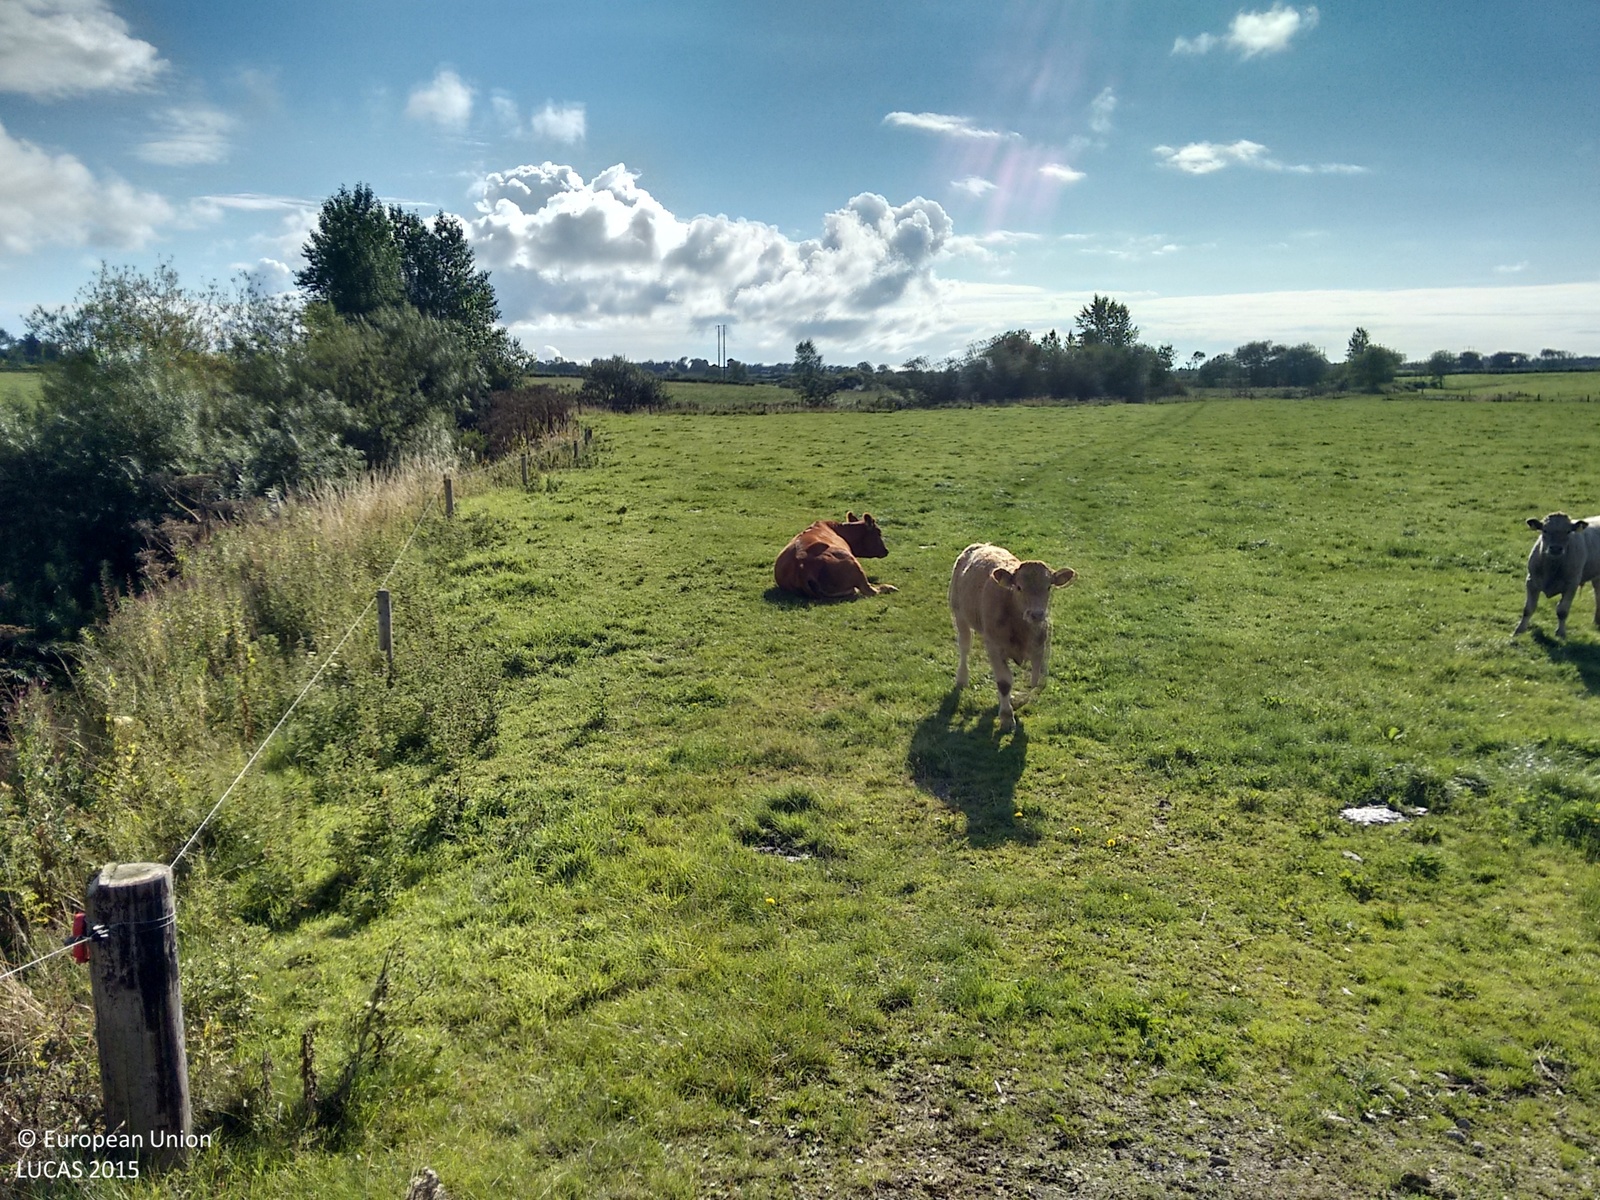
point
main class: Grassland
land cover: Grassland without tree/shrub cover
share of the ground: > 75 %
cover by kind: herbaceous plants 100 %
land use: Agriculture (excluding fallow land and kitchen gardens)
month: August
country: IE
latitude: 52.5682
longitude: -8.2584
